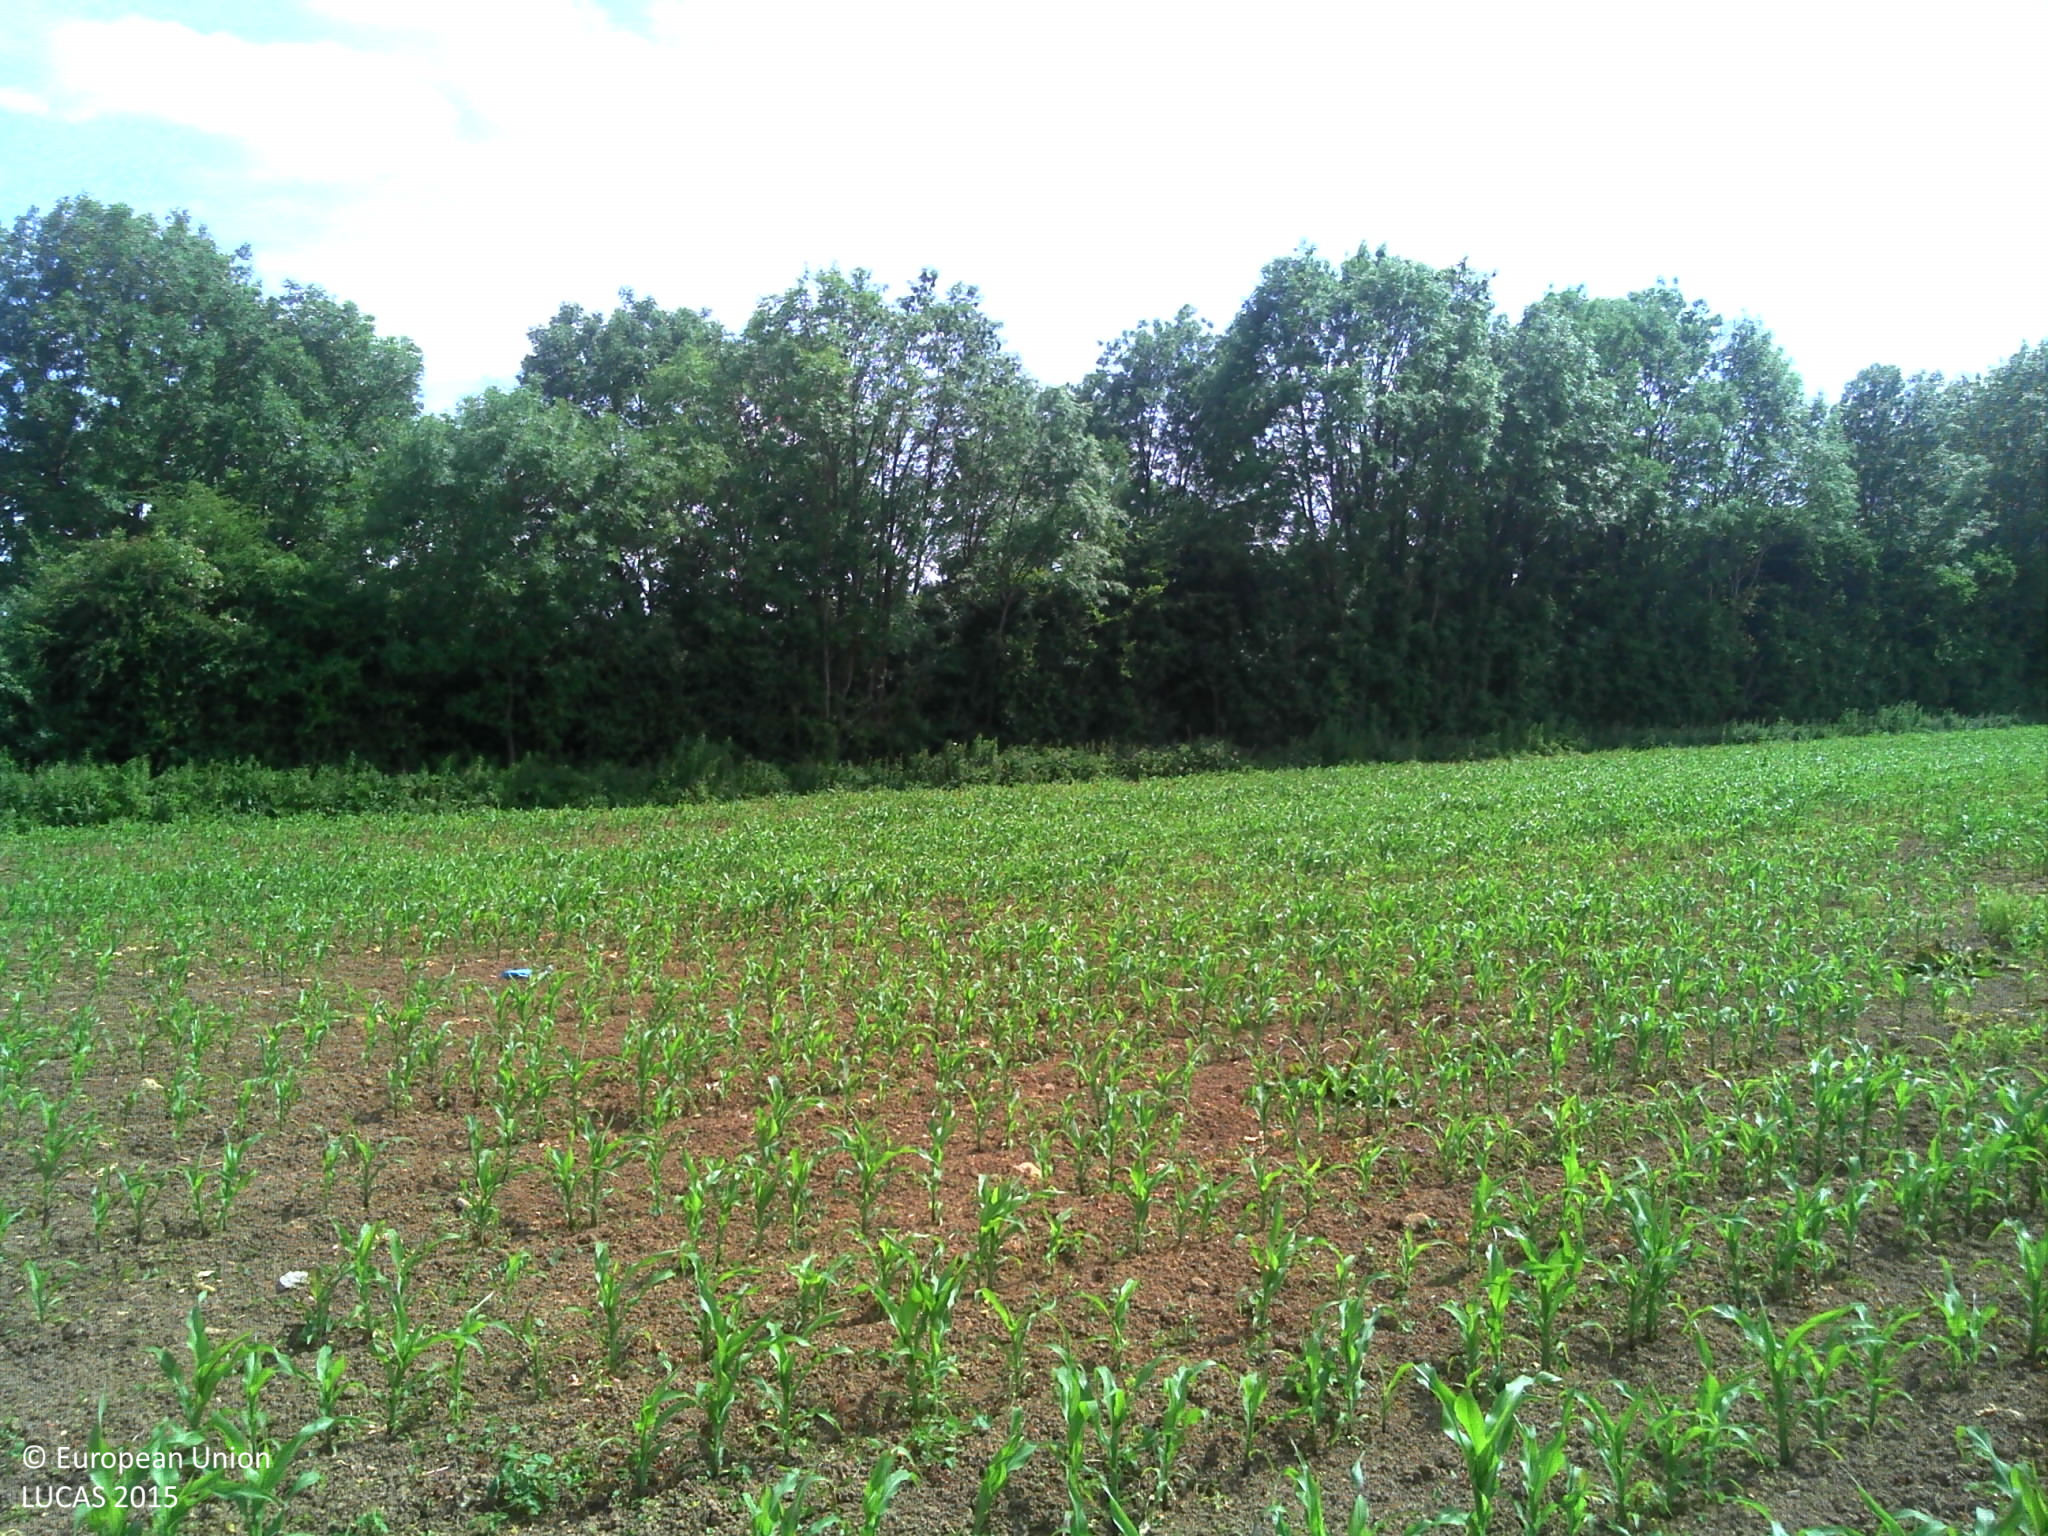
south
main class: Cropland
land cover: Maize
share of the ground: 10 - 25 %
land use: Agriculture (excluding fallow land and kitchen gardens)
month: June
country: FR
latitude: 48.4692
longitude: 0.1388
